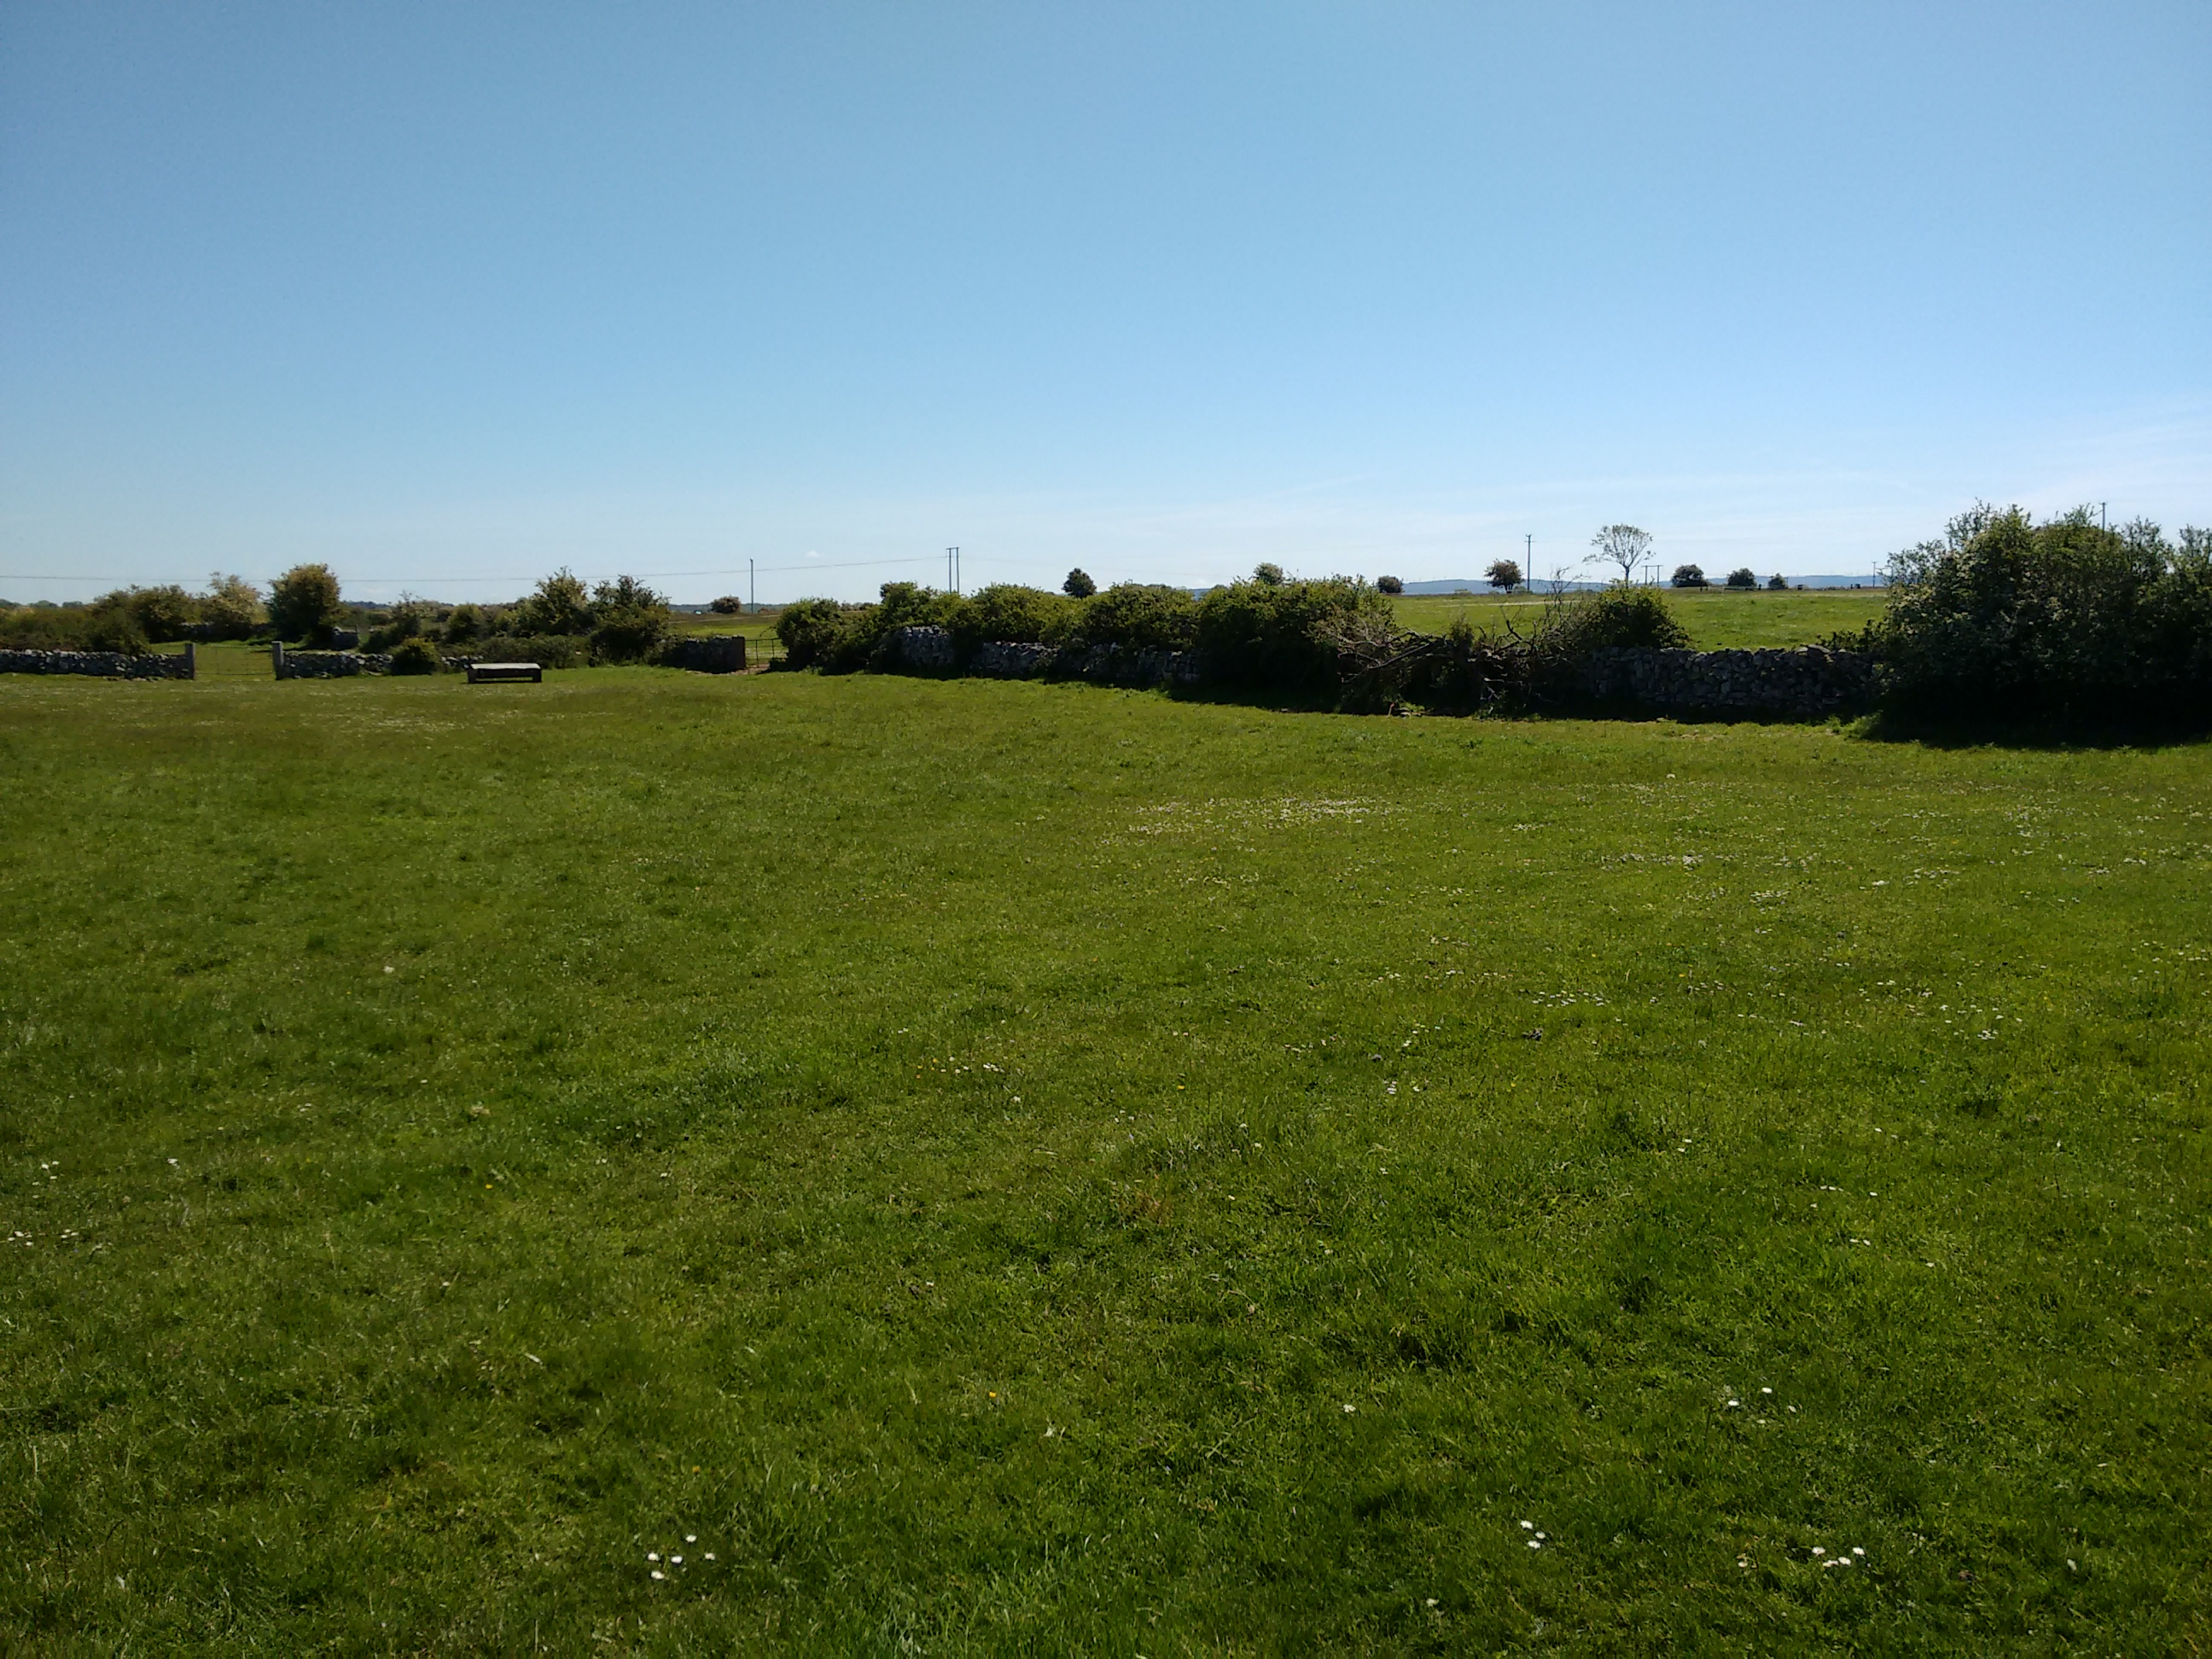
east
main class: Grassland
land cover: Grassland without tree/shrub cover
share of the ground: > 75 %
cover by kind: herbaceous plants 100 %
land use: Agriculture (excluding fallow land and kitchen gardens)
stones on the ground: < 10 %
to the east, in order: Grassland without tree/shrub cover; Dry stone walls; Managed hedges; Grassland without tree/shrub cover; Tracks; Grassland without tree/shrub cover; Electric lines; Grassland without tree/shrub cover; Single bushes/trees; Managed hedges; Grassland without tree/shrub cover
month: June
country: IE
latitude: 53.1753
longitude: -8.8642
